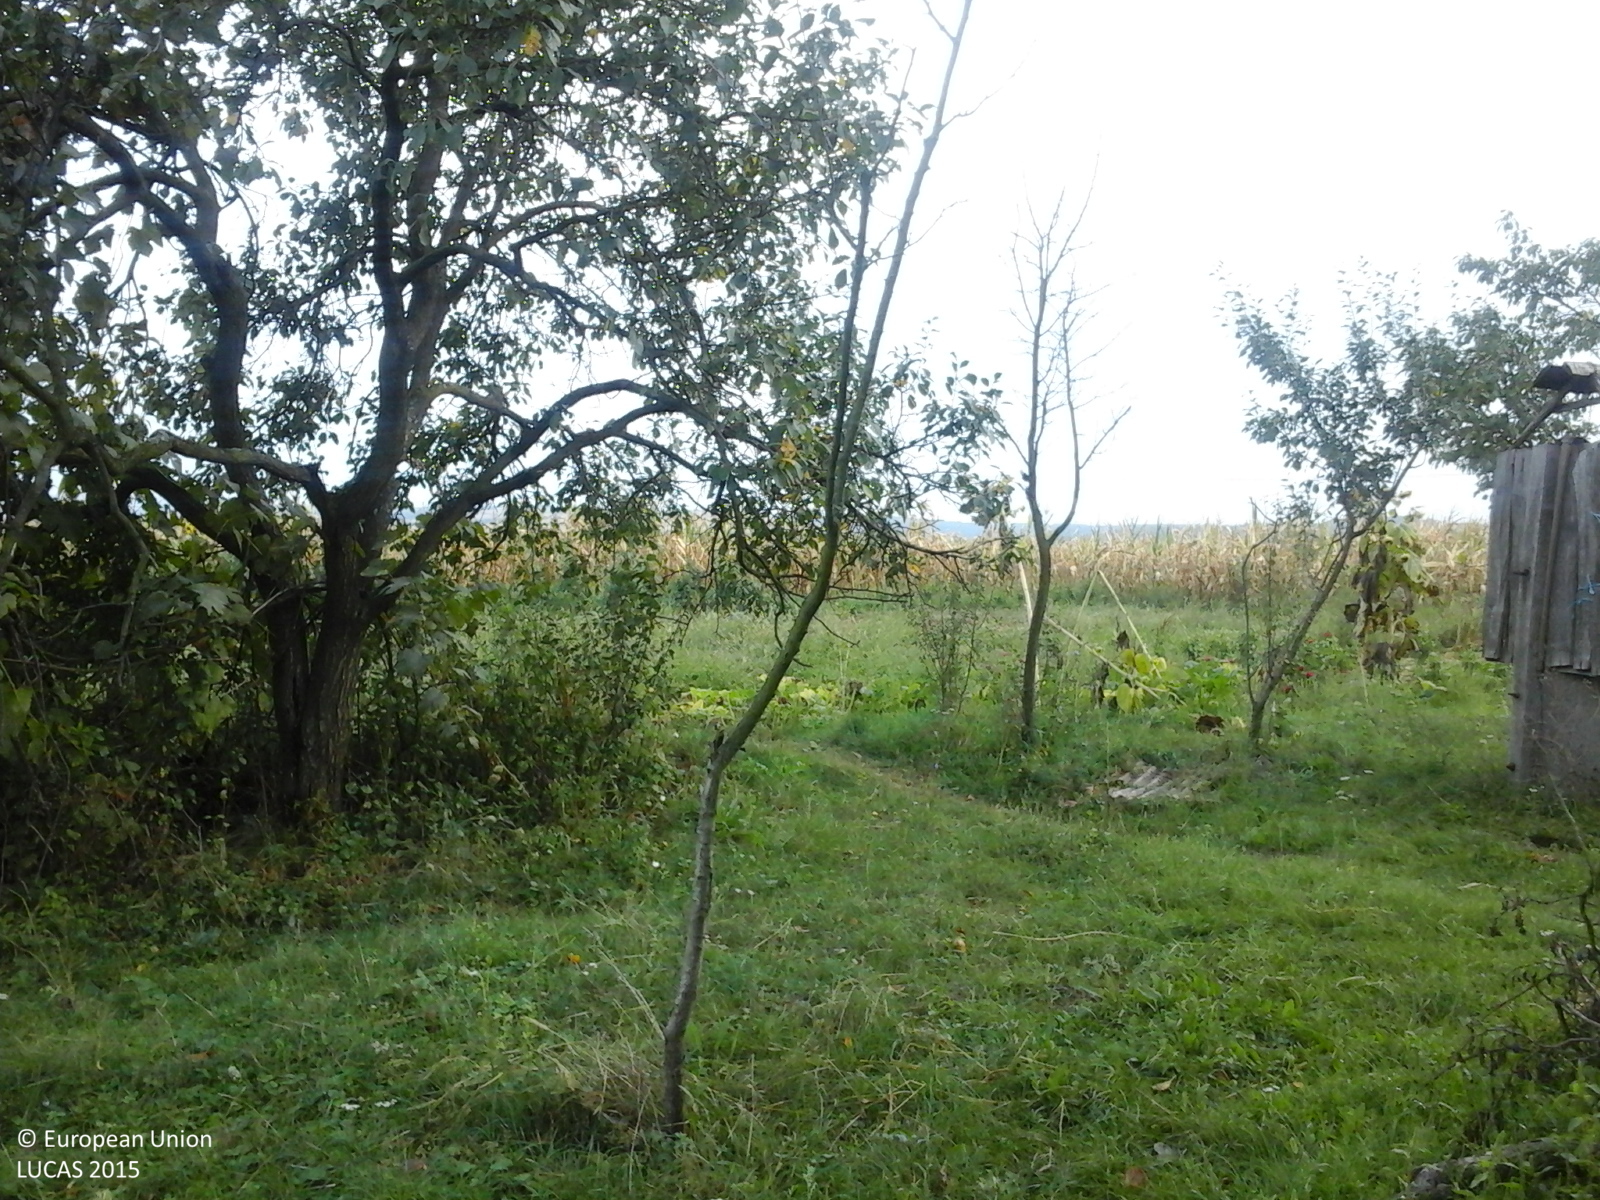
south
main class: Cropland
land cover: Other fruit trees and berries
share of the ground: > 75 %
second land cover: Grassland without tree/shrub cover
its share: > 75 %
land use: Agriculture (excluding fallow land and kitchen gardens)
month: September
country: RO
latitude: 47.4498
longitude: 22.5374
